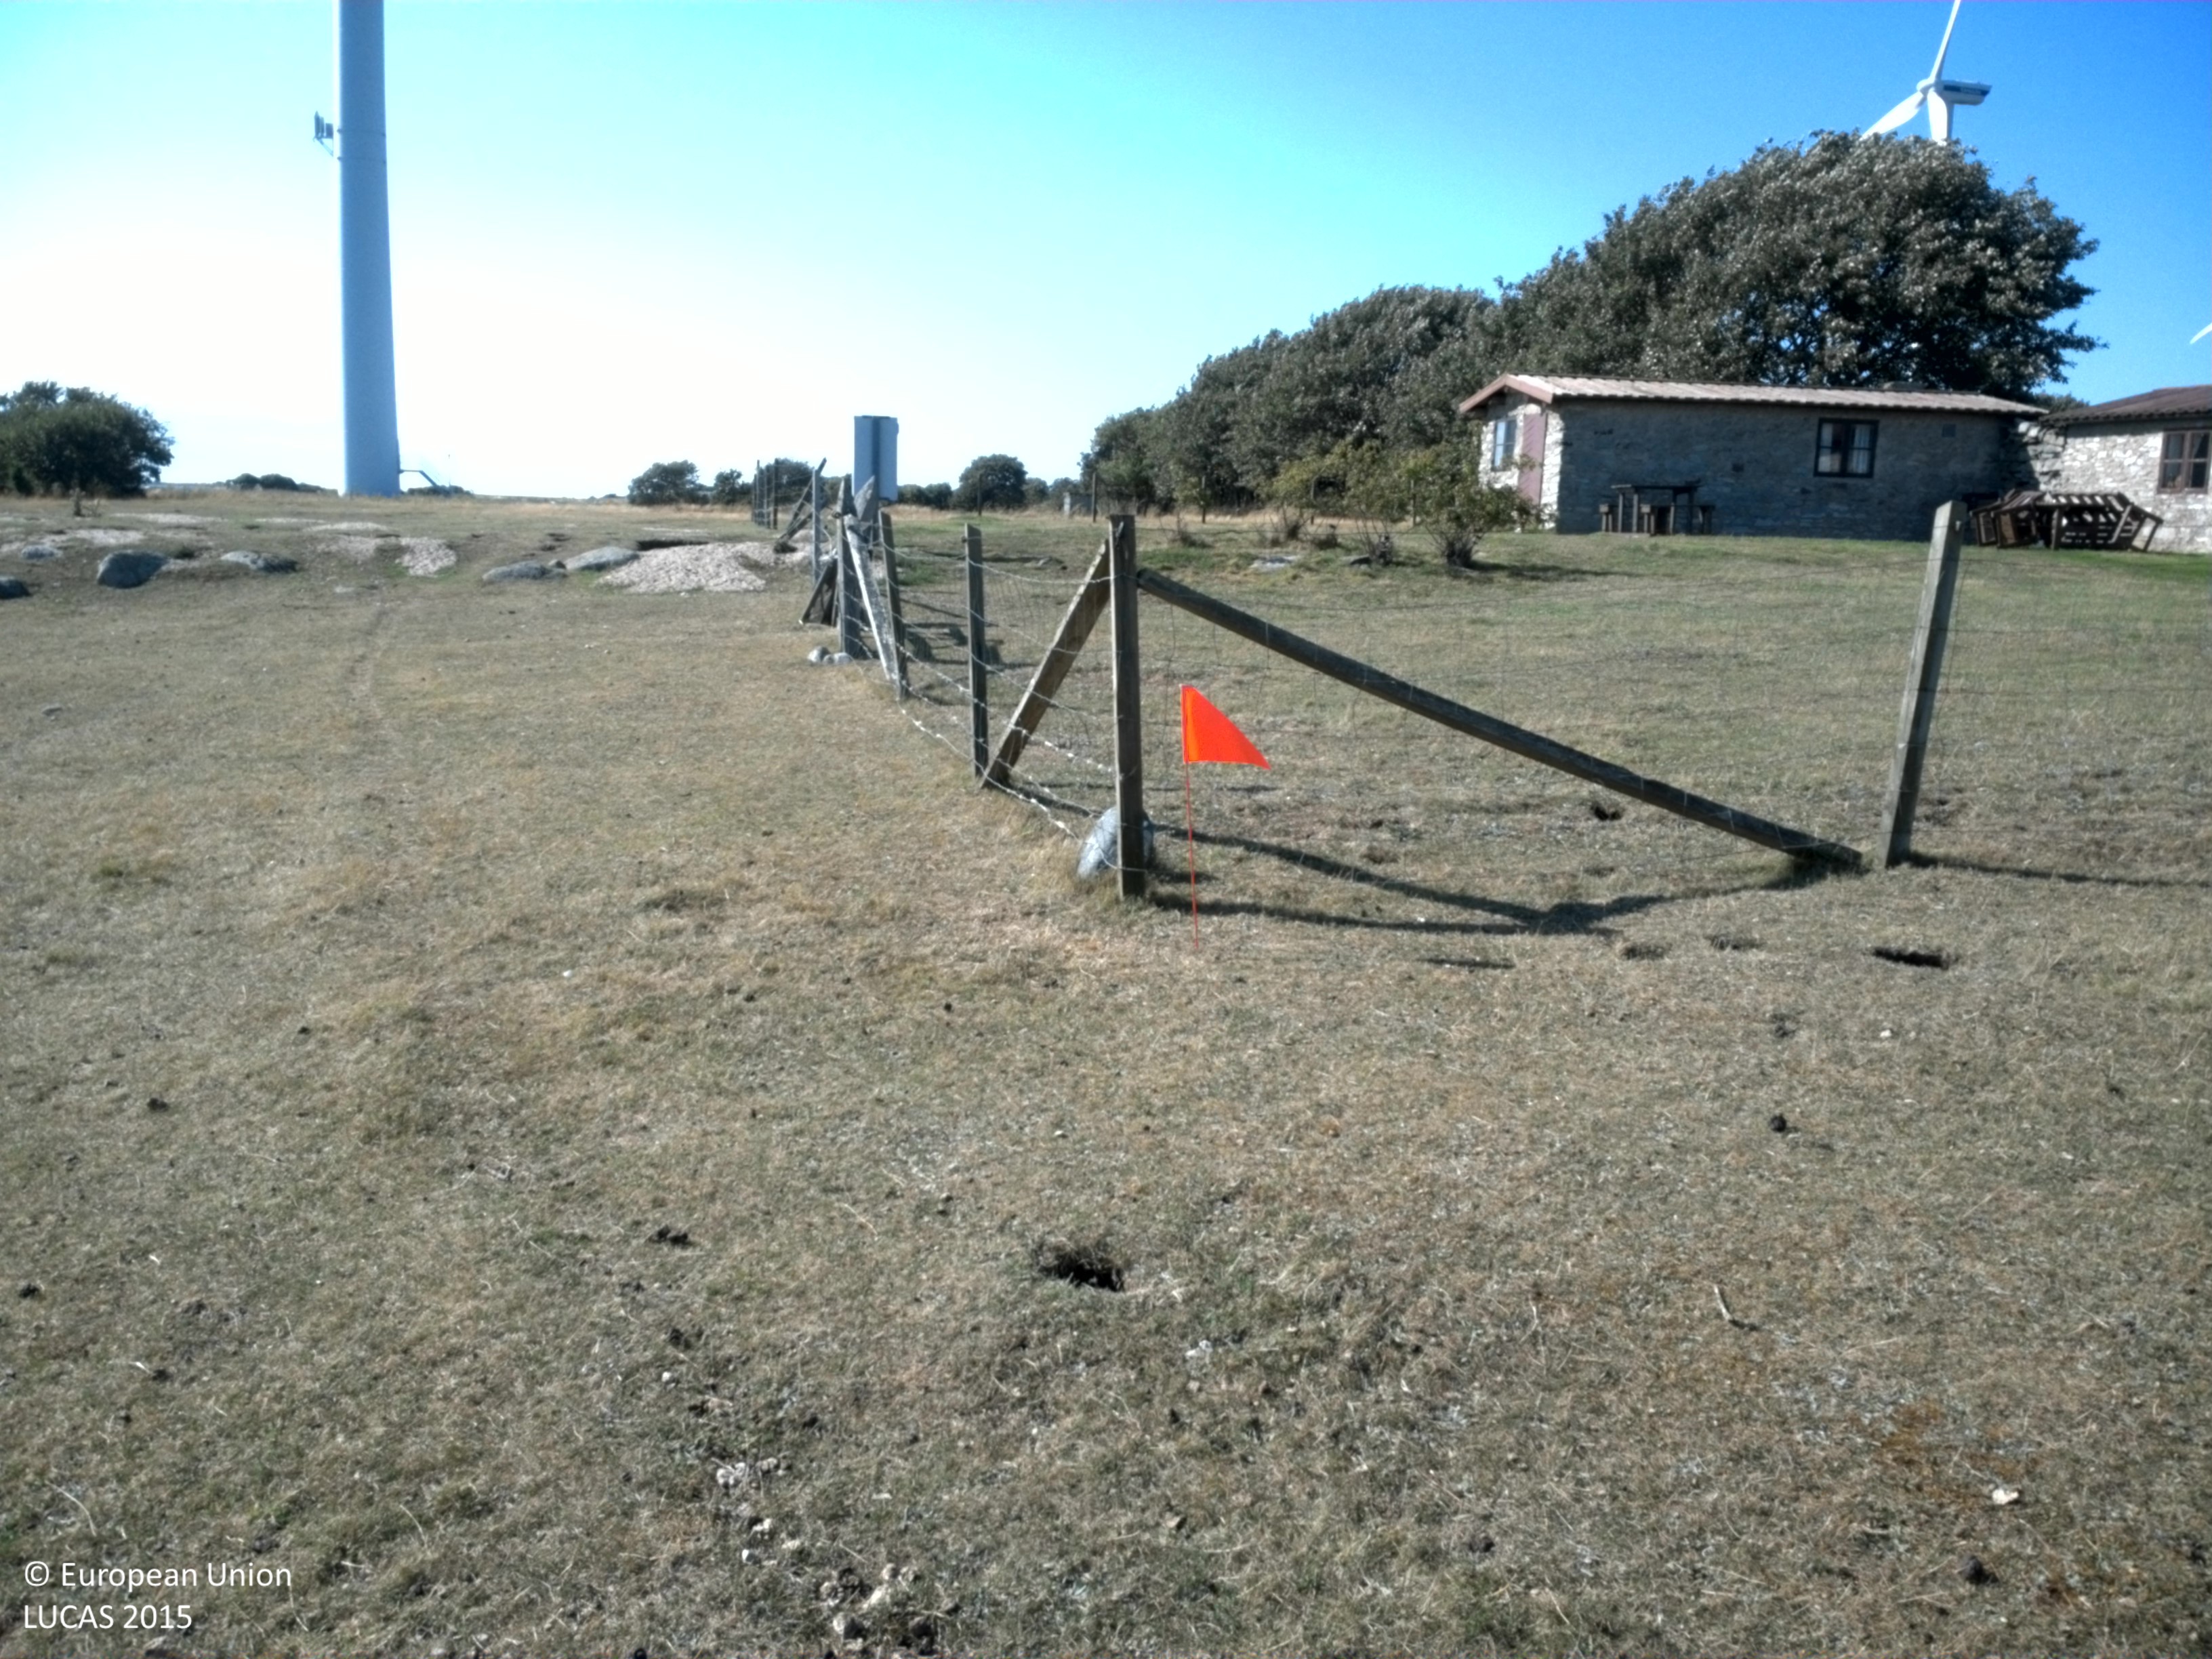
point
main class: Grassland
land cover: Grassland without tree/shrub cover
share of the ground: > 75 %
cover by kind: herbaceous plants 100 %
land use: Agriculture (excluding fallow land and kitchen gardens)
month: July
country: SE
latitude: 57.0641
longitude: 18.2043
